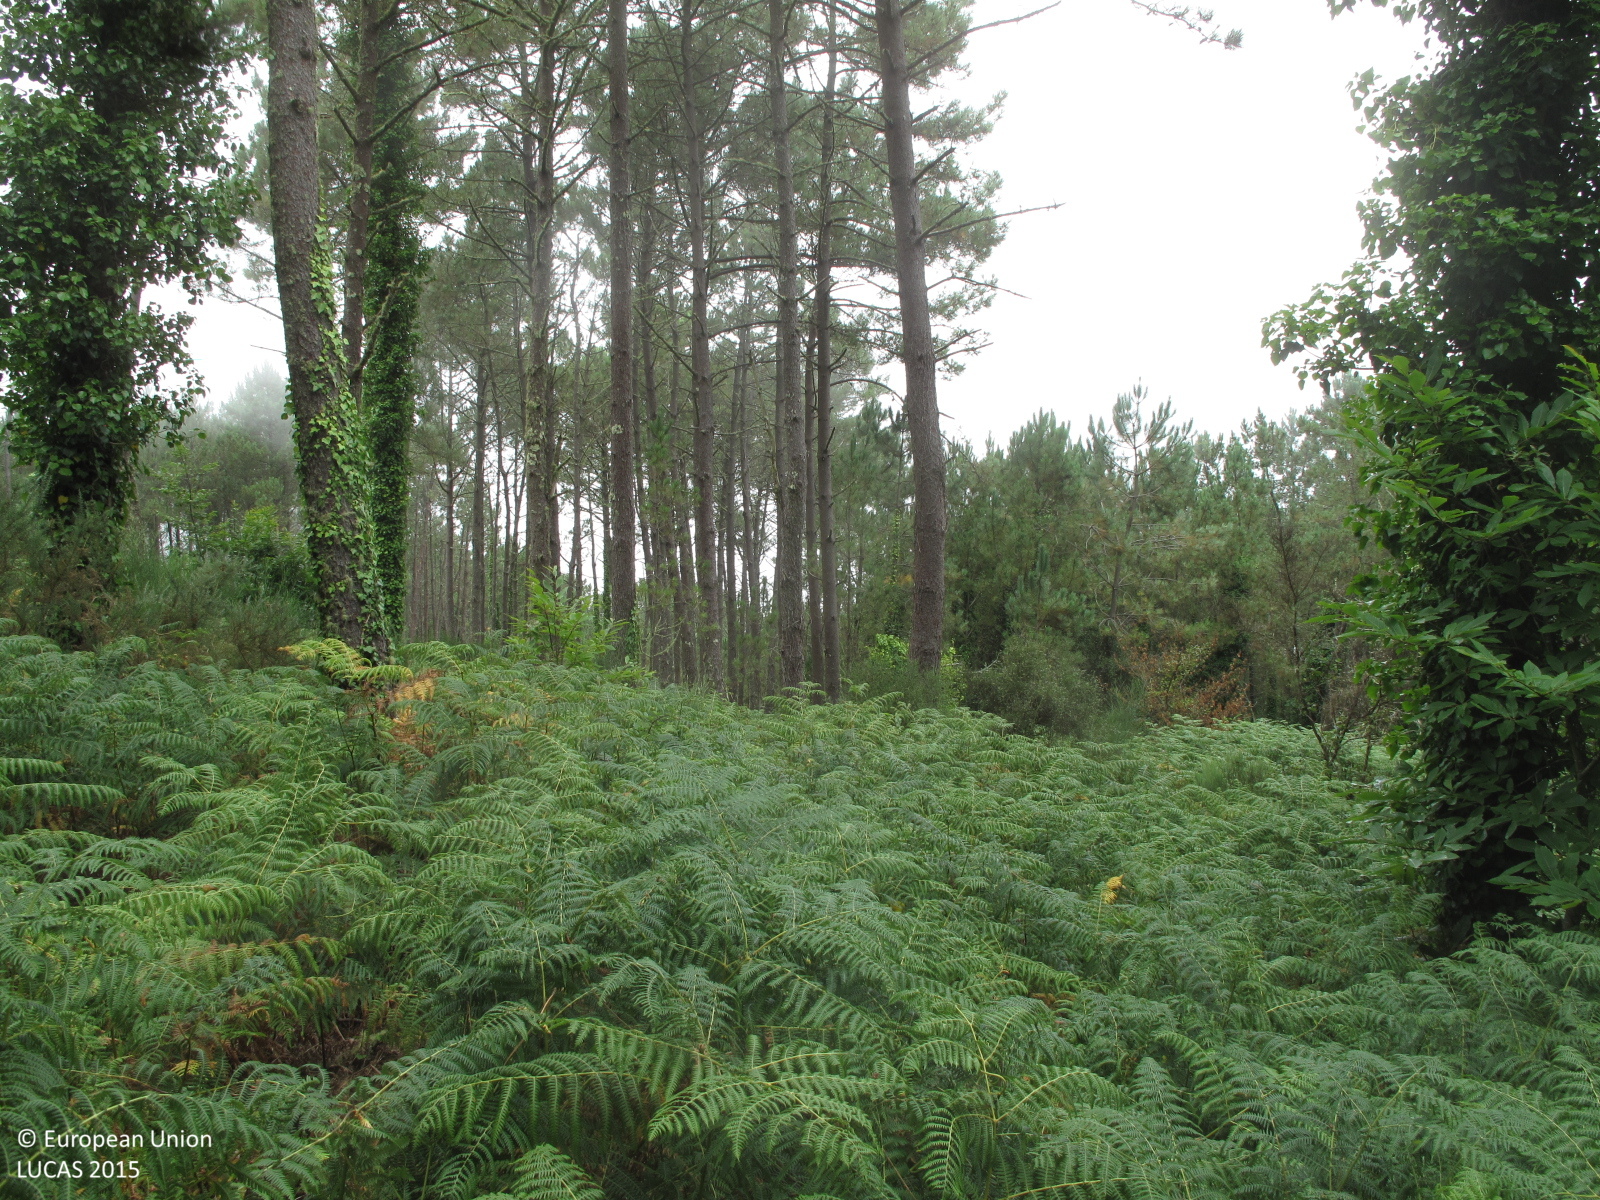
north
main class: Woodland
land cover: Pine dominated coniferous woodland
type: hemiboreal forest and nemoral coniferous forest and mixed broadleaved-coniferous forest
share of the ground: 50 - 75 %
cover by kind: coniferous forest trees 65 %, herbaceous plants 20 %, shrubs 10 %, broadleaved forest trees 5 %
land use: Forestry
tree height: > 5 m
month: July
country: ES
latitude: 42.9282
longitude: -9.2802
